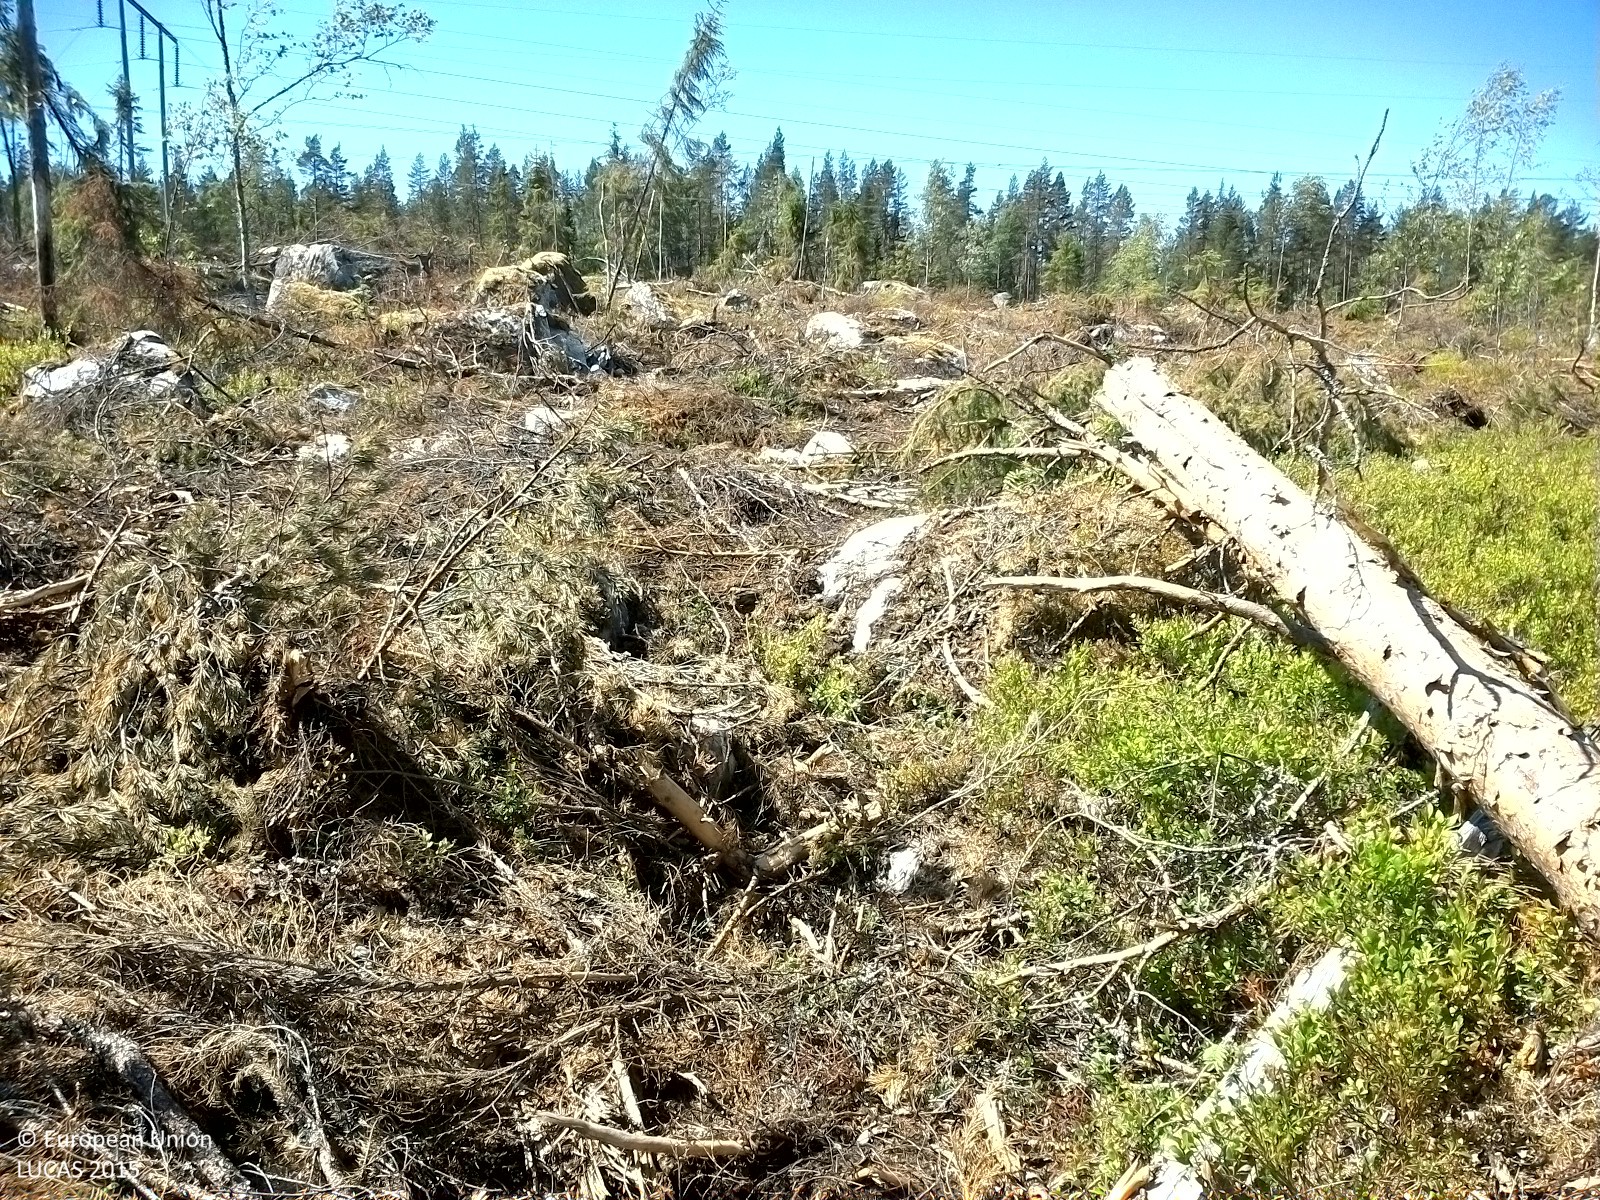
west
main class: Shrubland
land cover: Shrubland with sparse tree cover
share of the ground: 50 - 75 %
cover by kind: shrubs 55 %, unconsolidated bare surface 15 %, broadleaved forest trees 5 %
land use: Forestry
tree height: < 5 m
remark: Clear cut
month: July
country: SE
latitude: 62.2338
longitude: 16.9655
